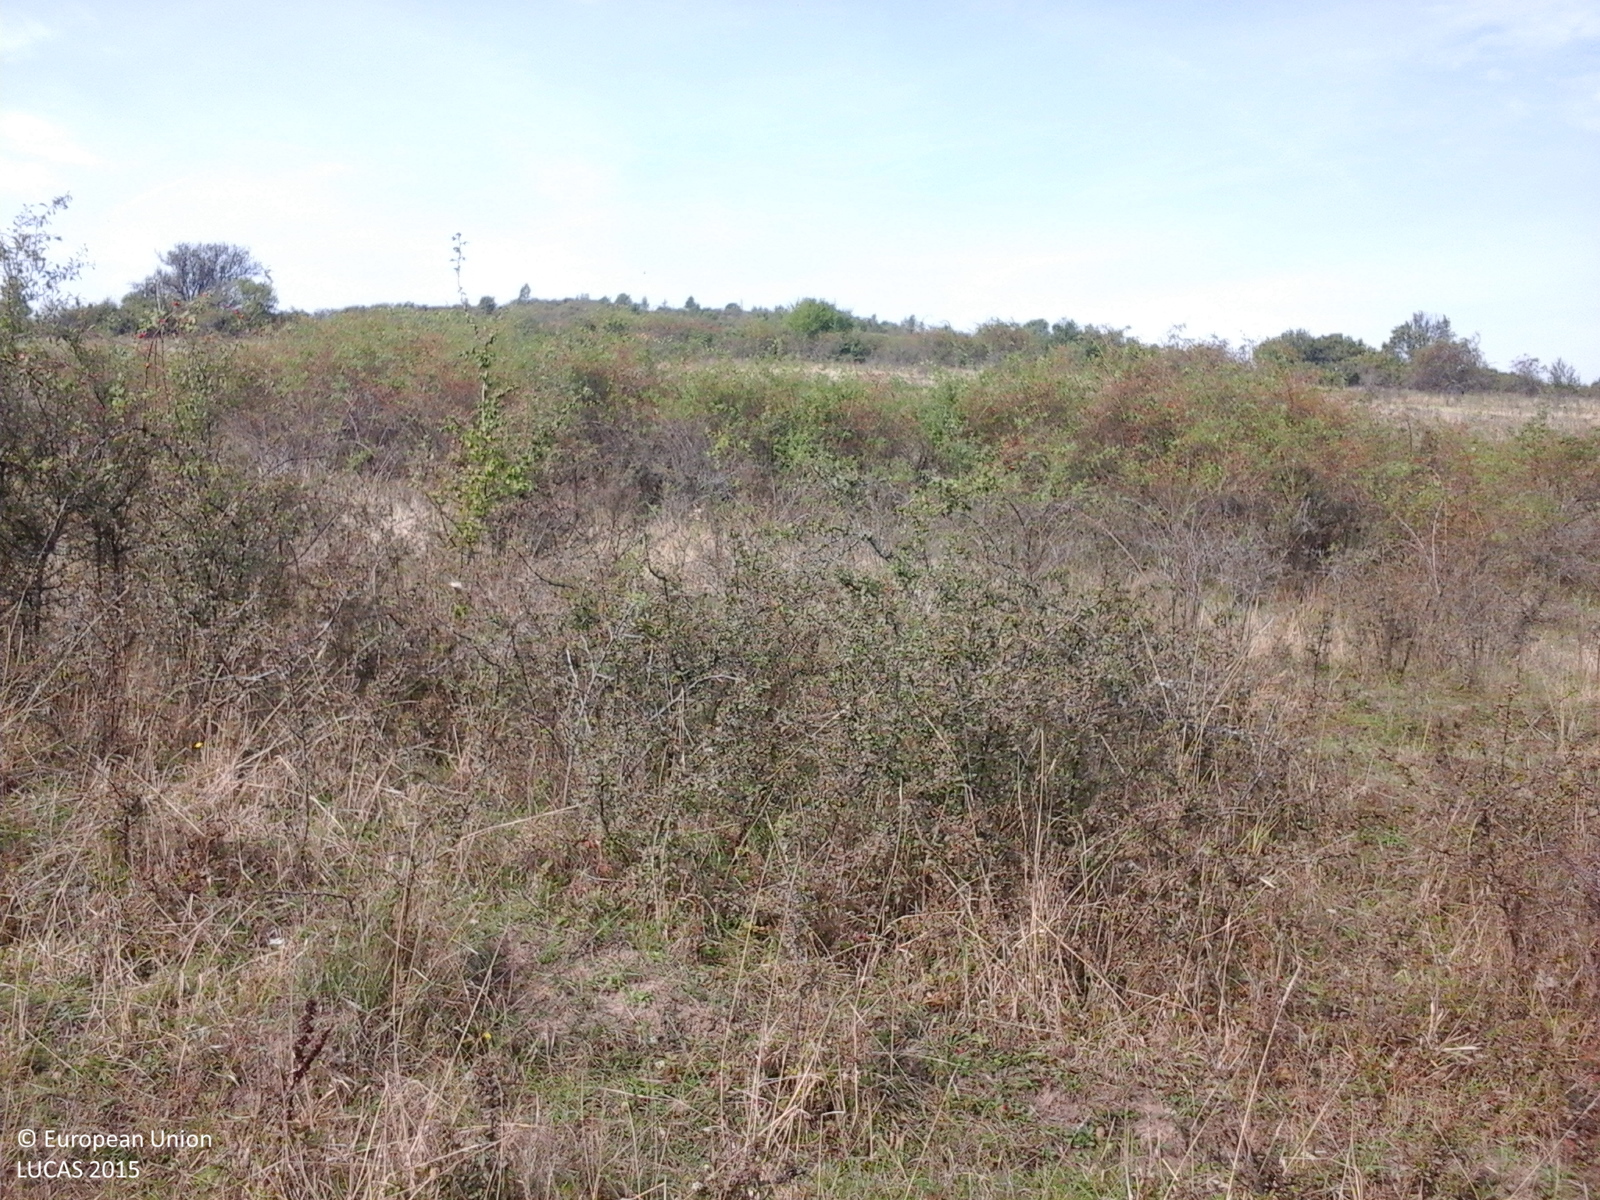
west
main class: Grassland
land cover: Spontaneously vegetated surfaces
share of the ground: > 75 %
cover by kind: herbaceous plants 100 %
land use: Fallow land
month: September
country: RO
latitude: 47.1545
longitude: 23.6192
